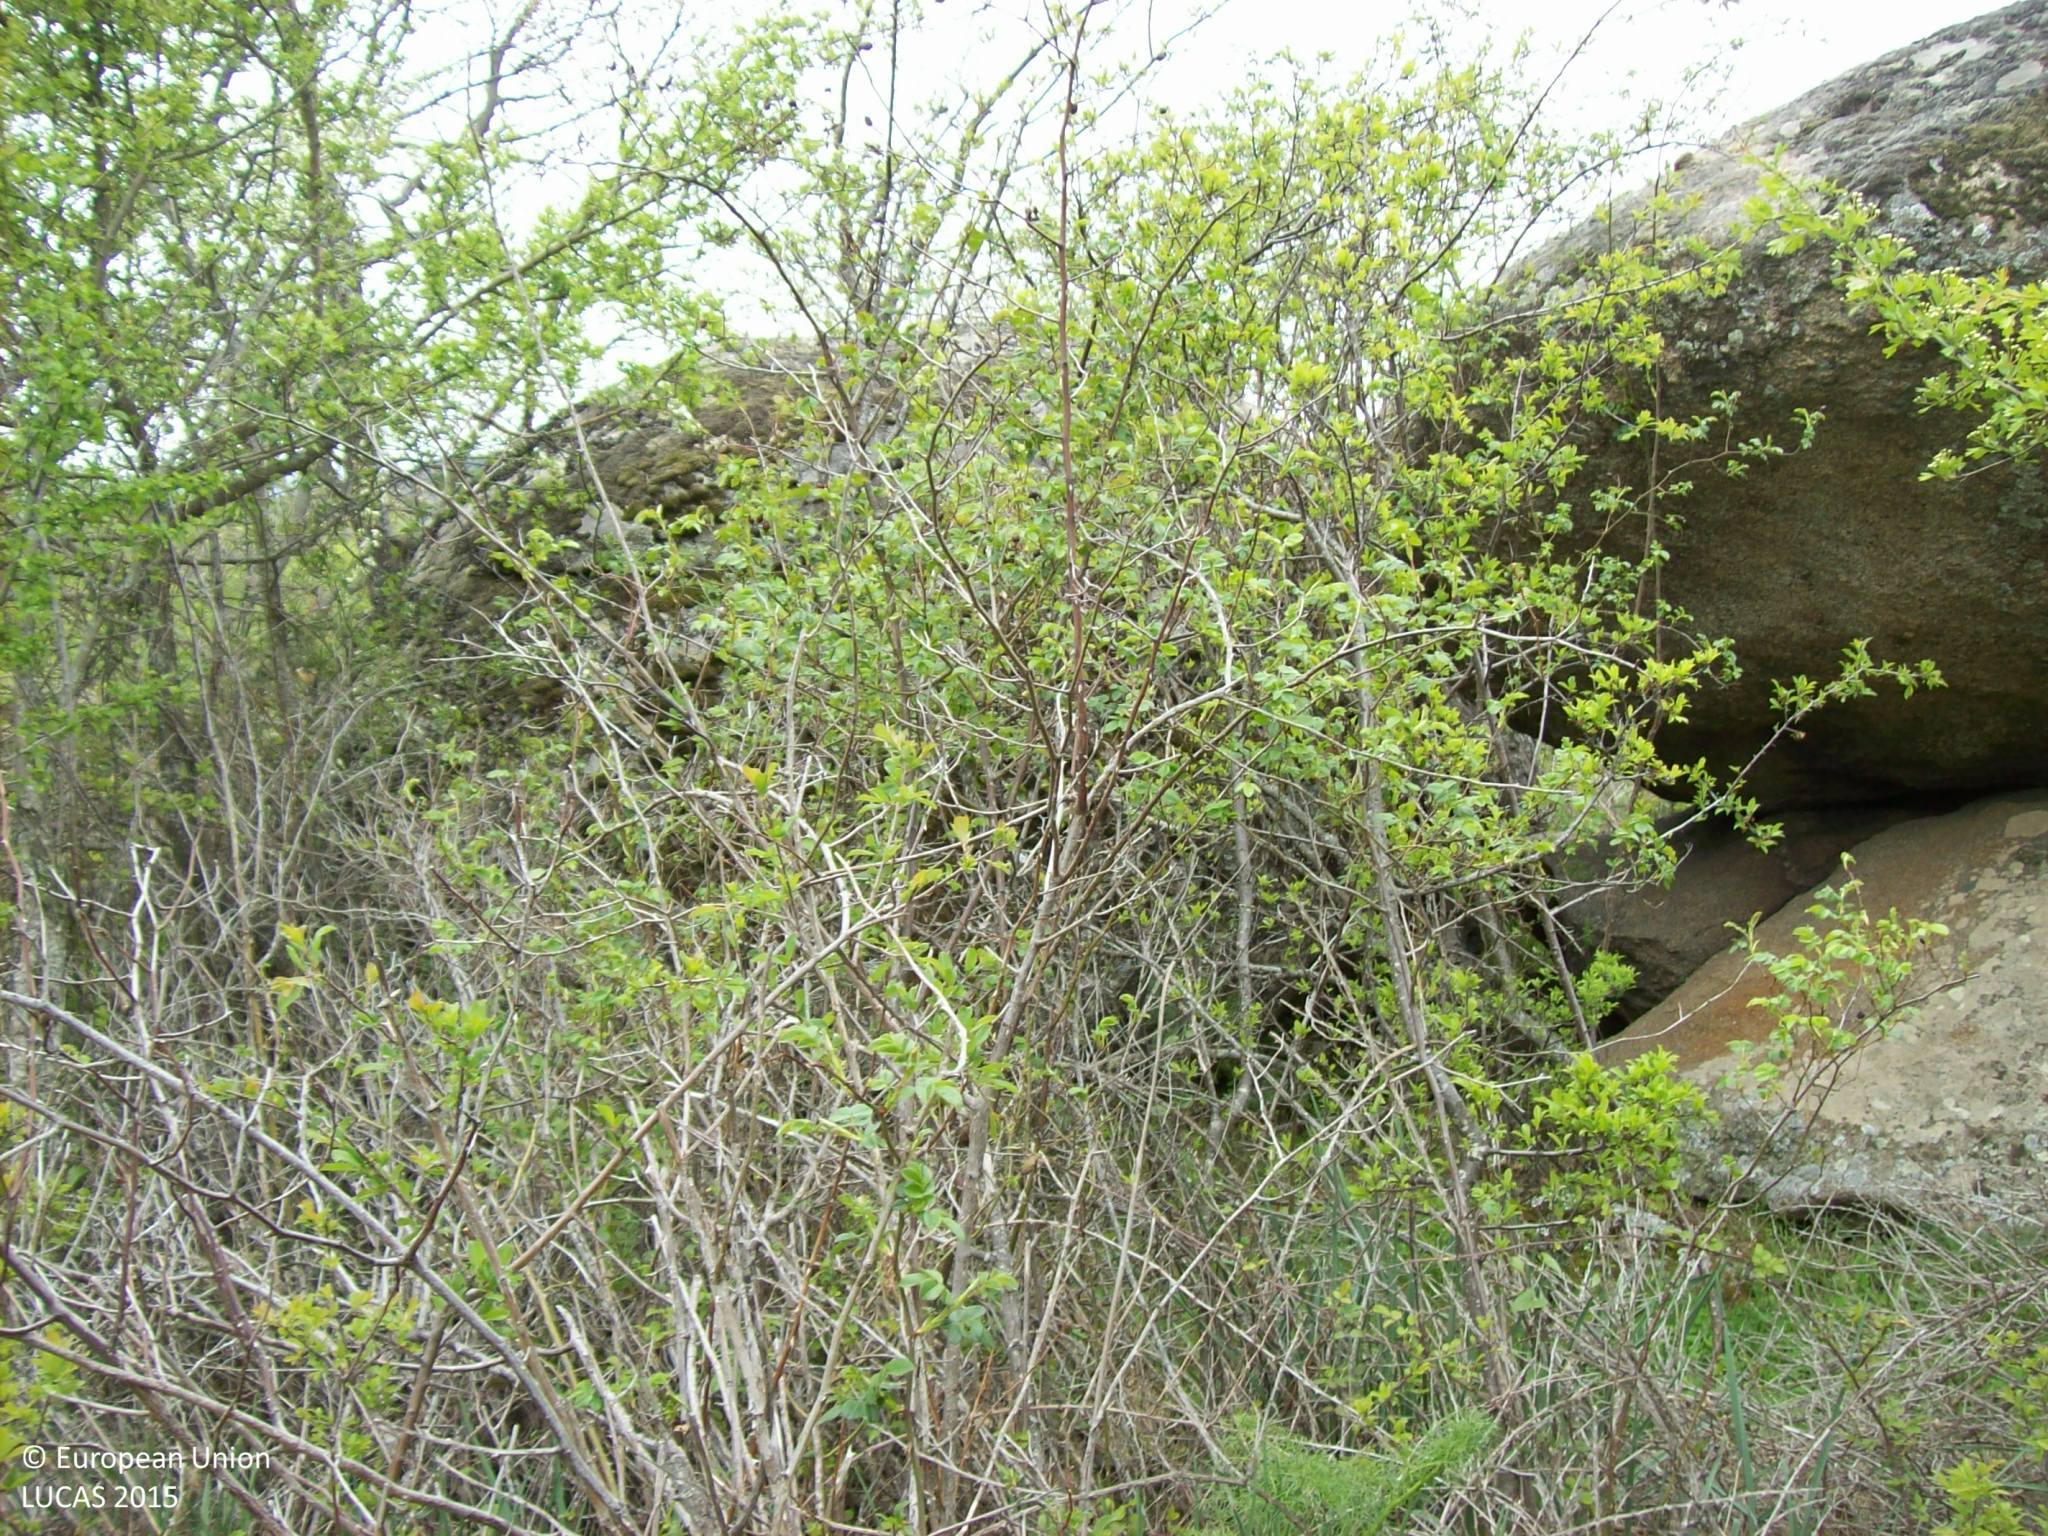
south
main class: Woodland
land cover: Broadleaved woodland
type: acidophilous oak and oak-birch forest
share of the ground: 10 - 25 %
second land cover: Grassland without tree/shrub cover
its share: > 75 %
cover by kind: herbaceous plants 40 %, consolidated bare surface 25 %, broadleaved forest trees 20 %, shrubs 15 %
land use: Forestry
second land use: Agriculture (excluding fallow land and kitchen gardens)
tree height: > 5 m
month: April
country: ES
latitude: 40.4372
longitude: -4.8259
